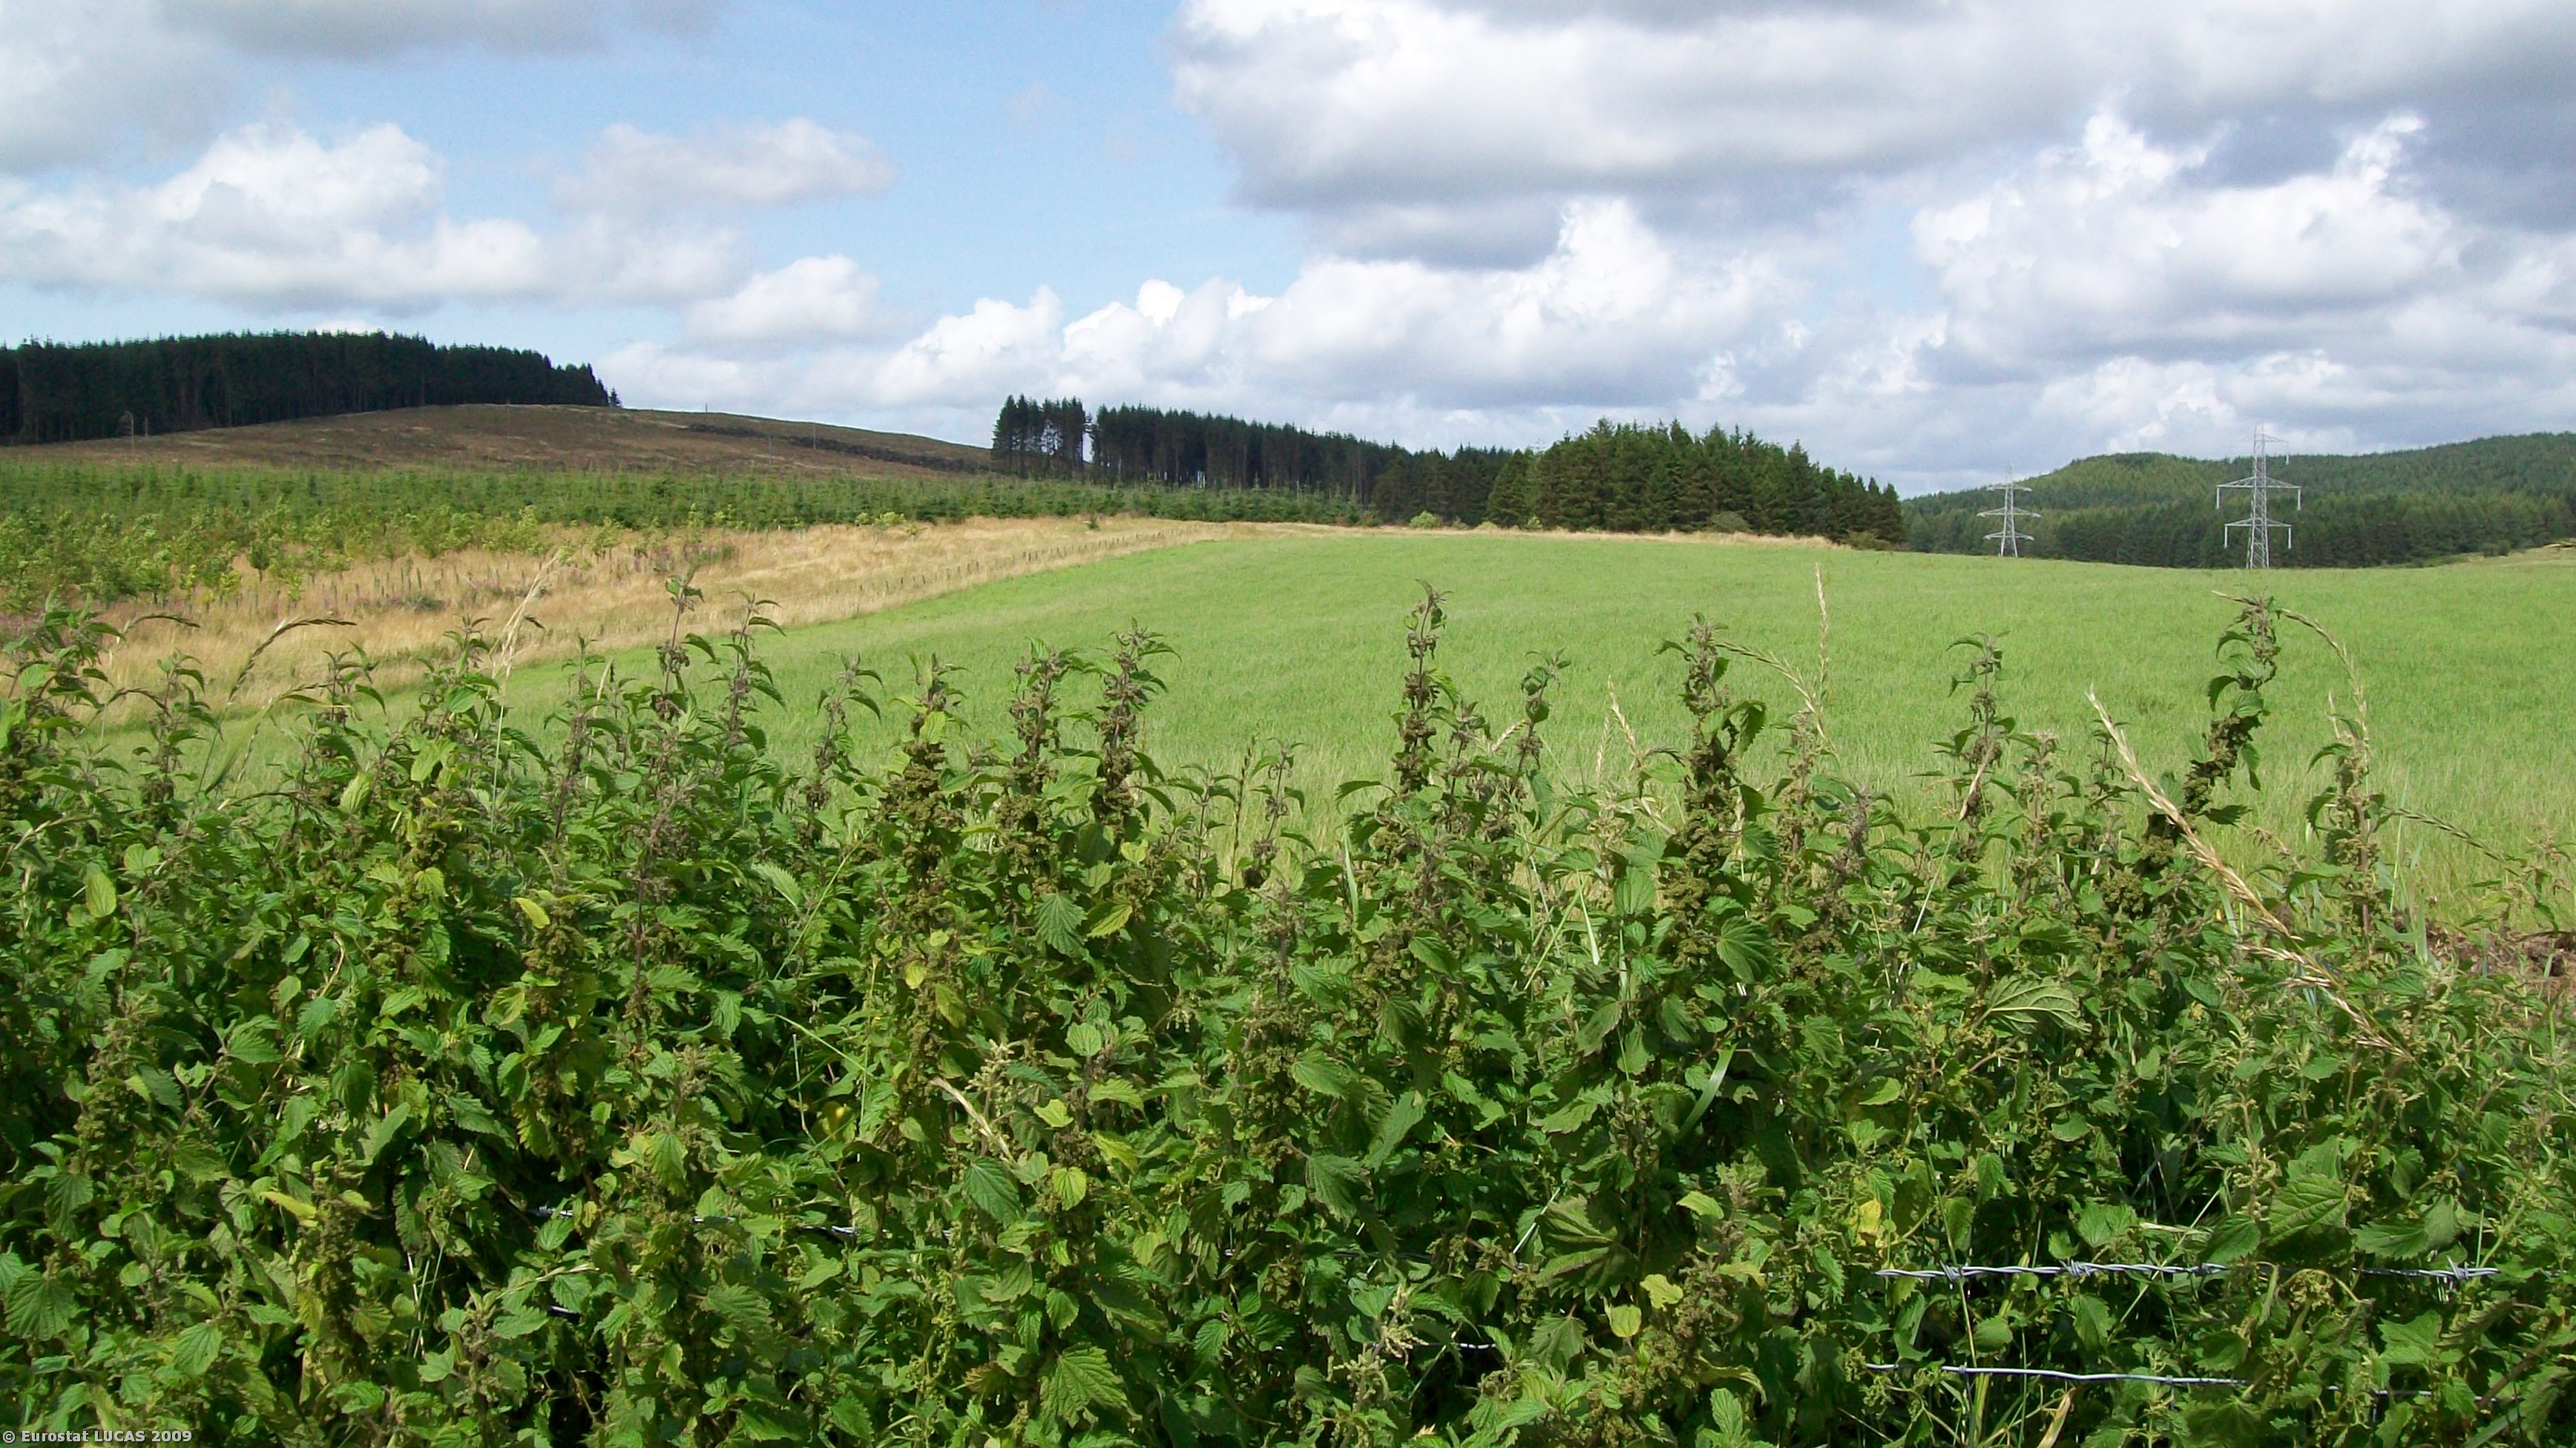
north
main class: Grassland
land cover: Grassland without tree/shrub cover
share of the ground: > 75 %
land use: Agriculture (excluding fallow land and kitchen gardens)
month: August
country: GB
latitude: 55.2291
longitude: -3.3630
